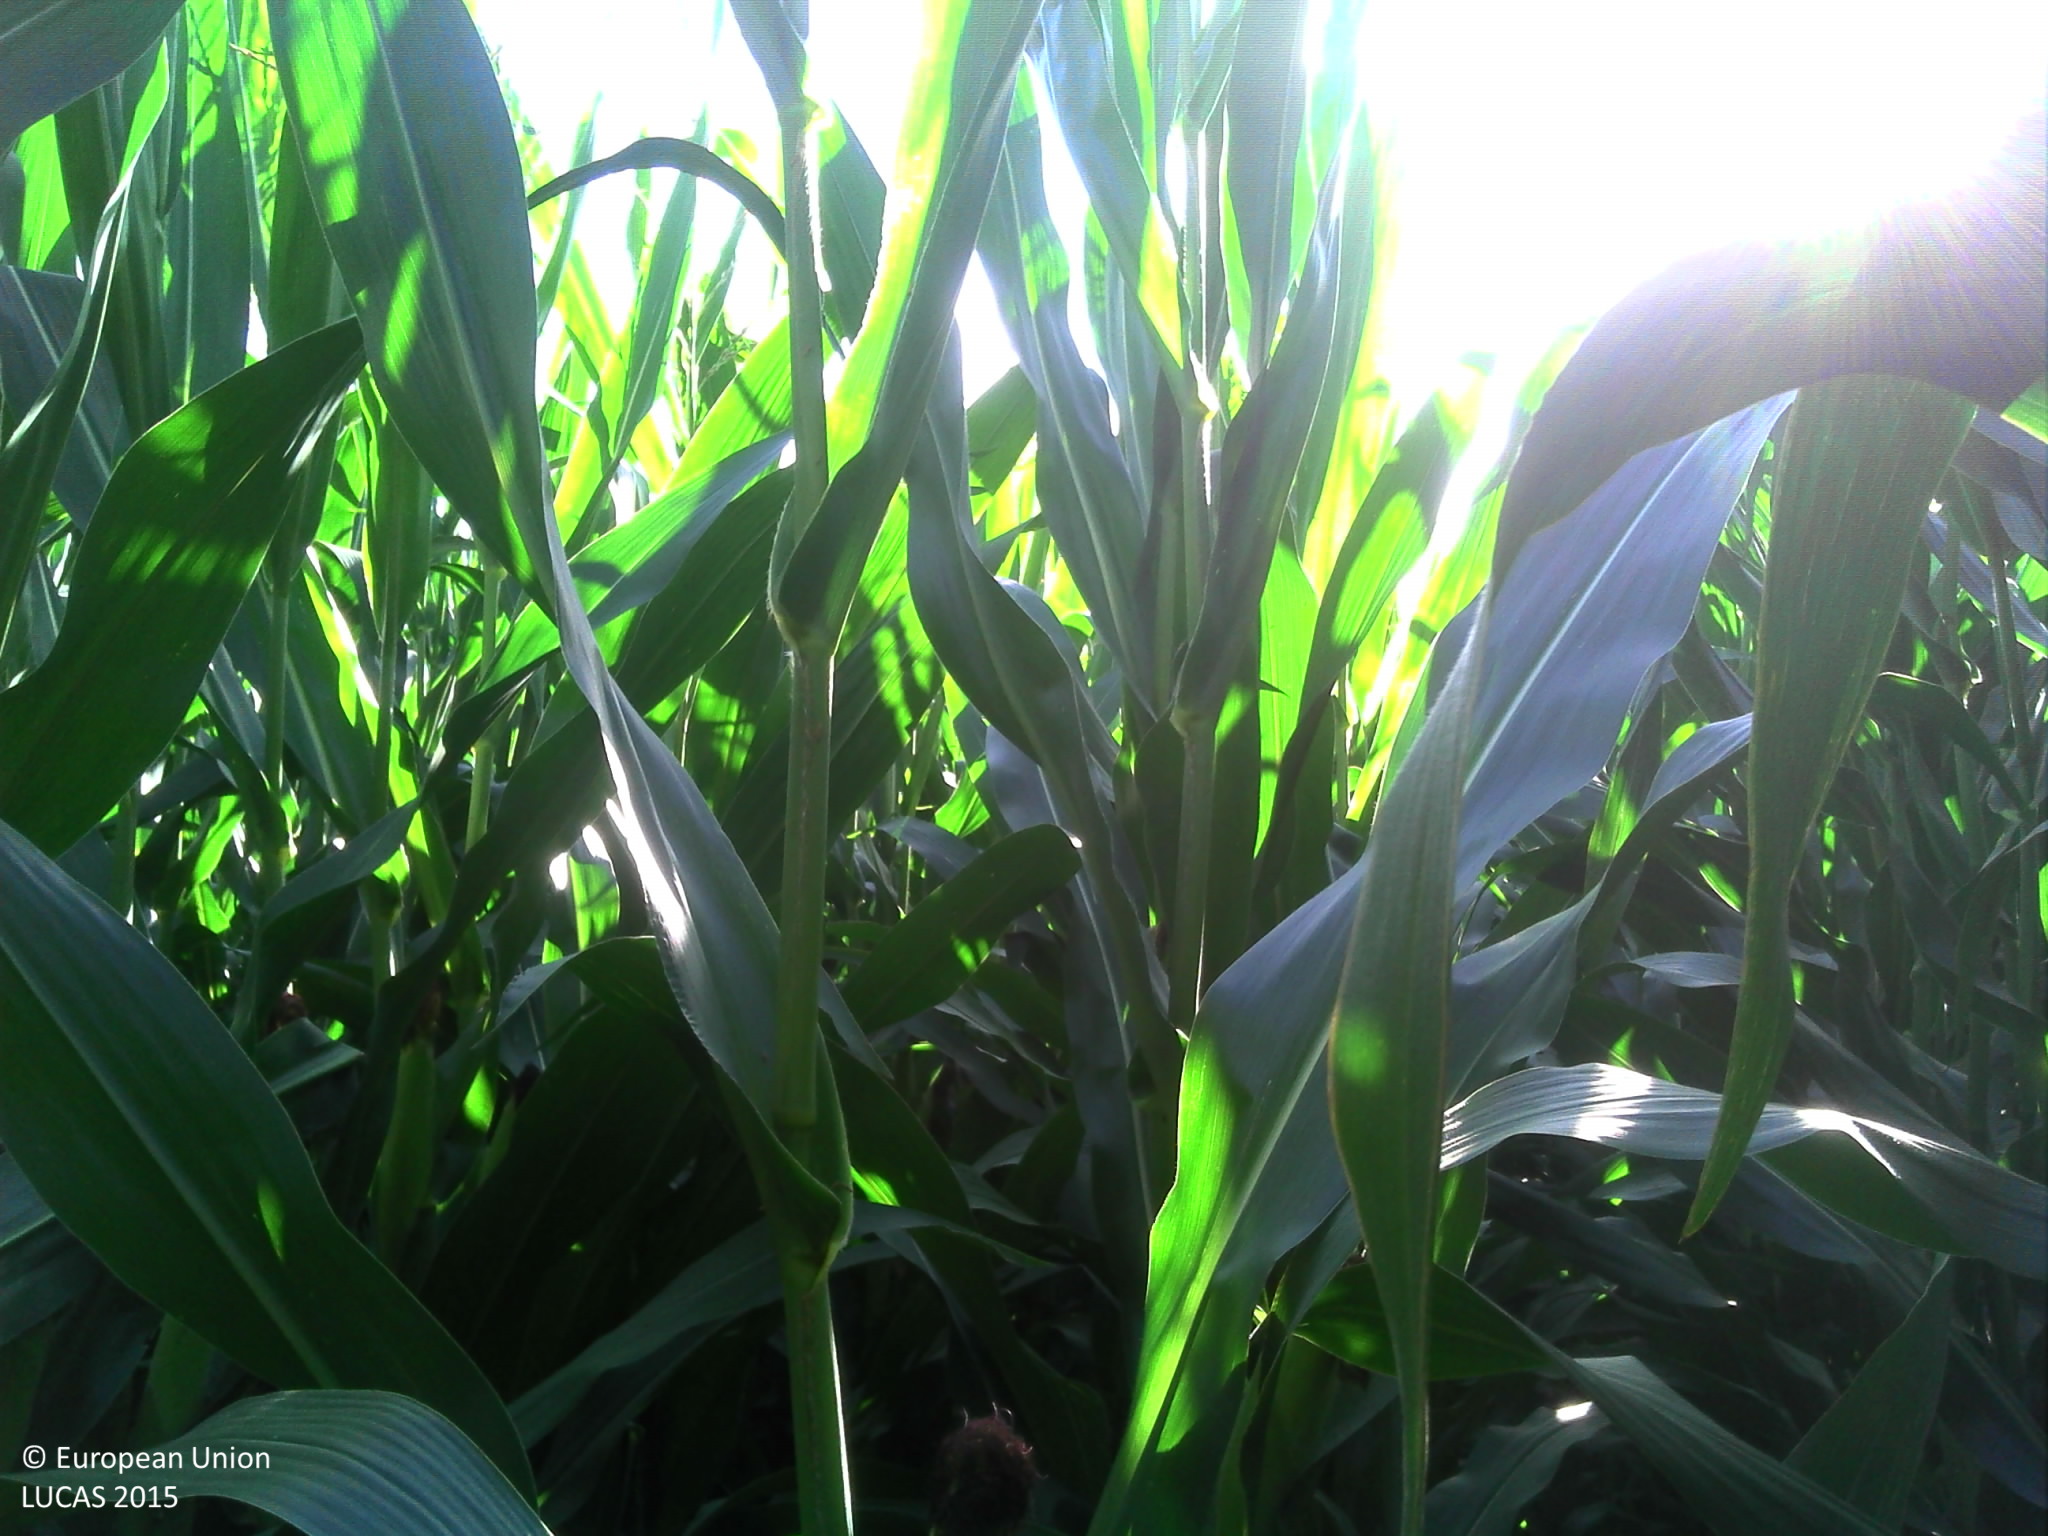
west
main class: Cropland
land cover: Maize
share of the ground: > 75 %
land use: Agriculture (excluding fallow land and kitchen gardens)
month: August
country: FR
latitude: 46.7589
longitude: -1.3889
